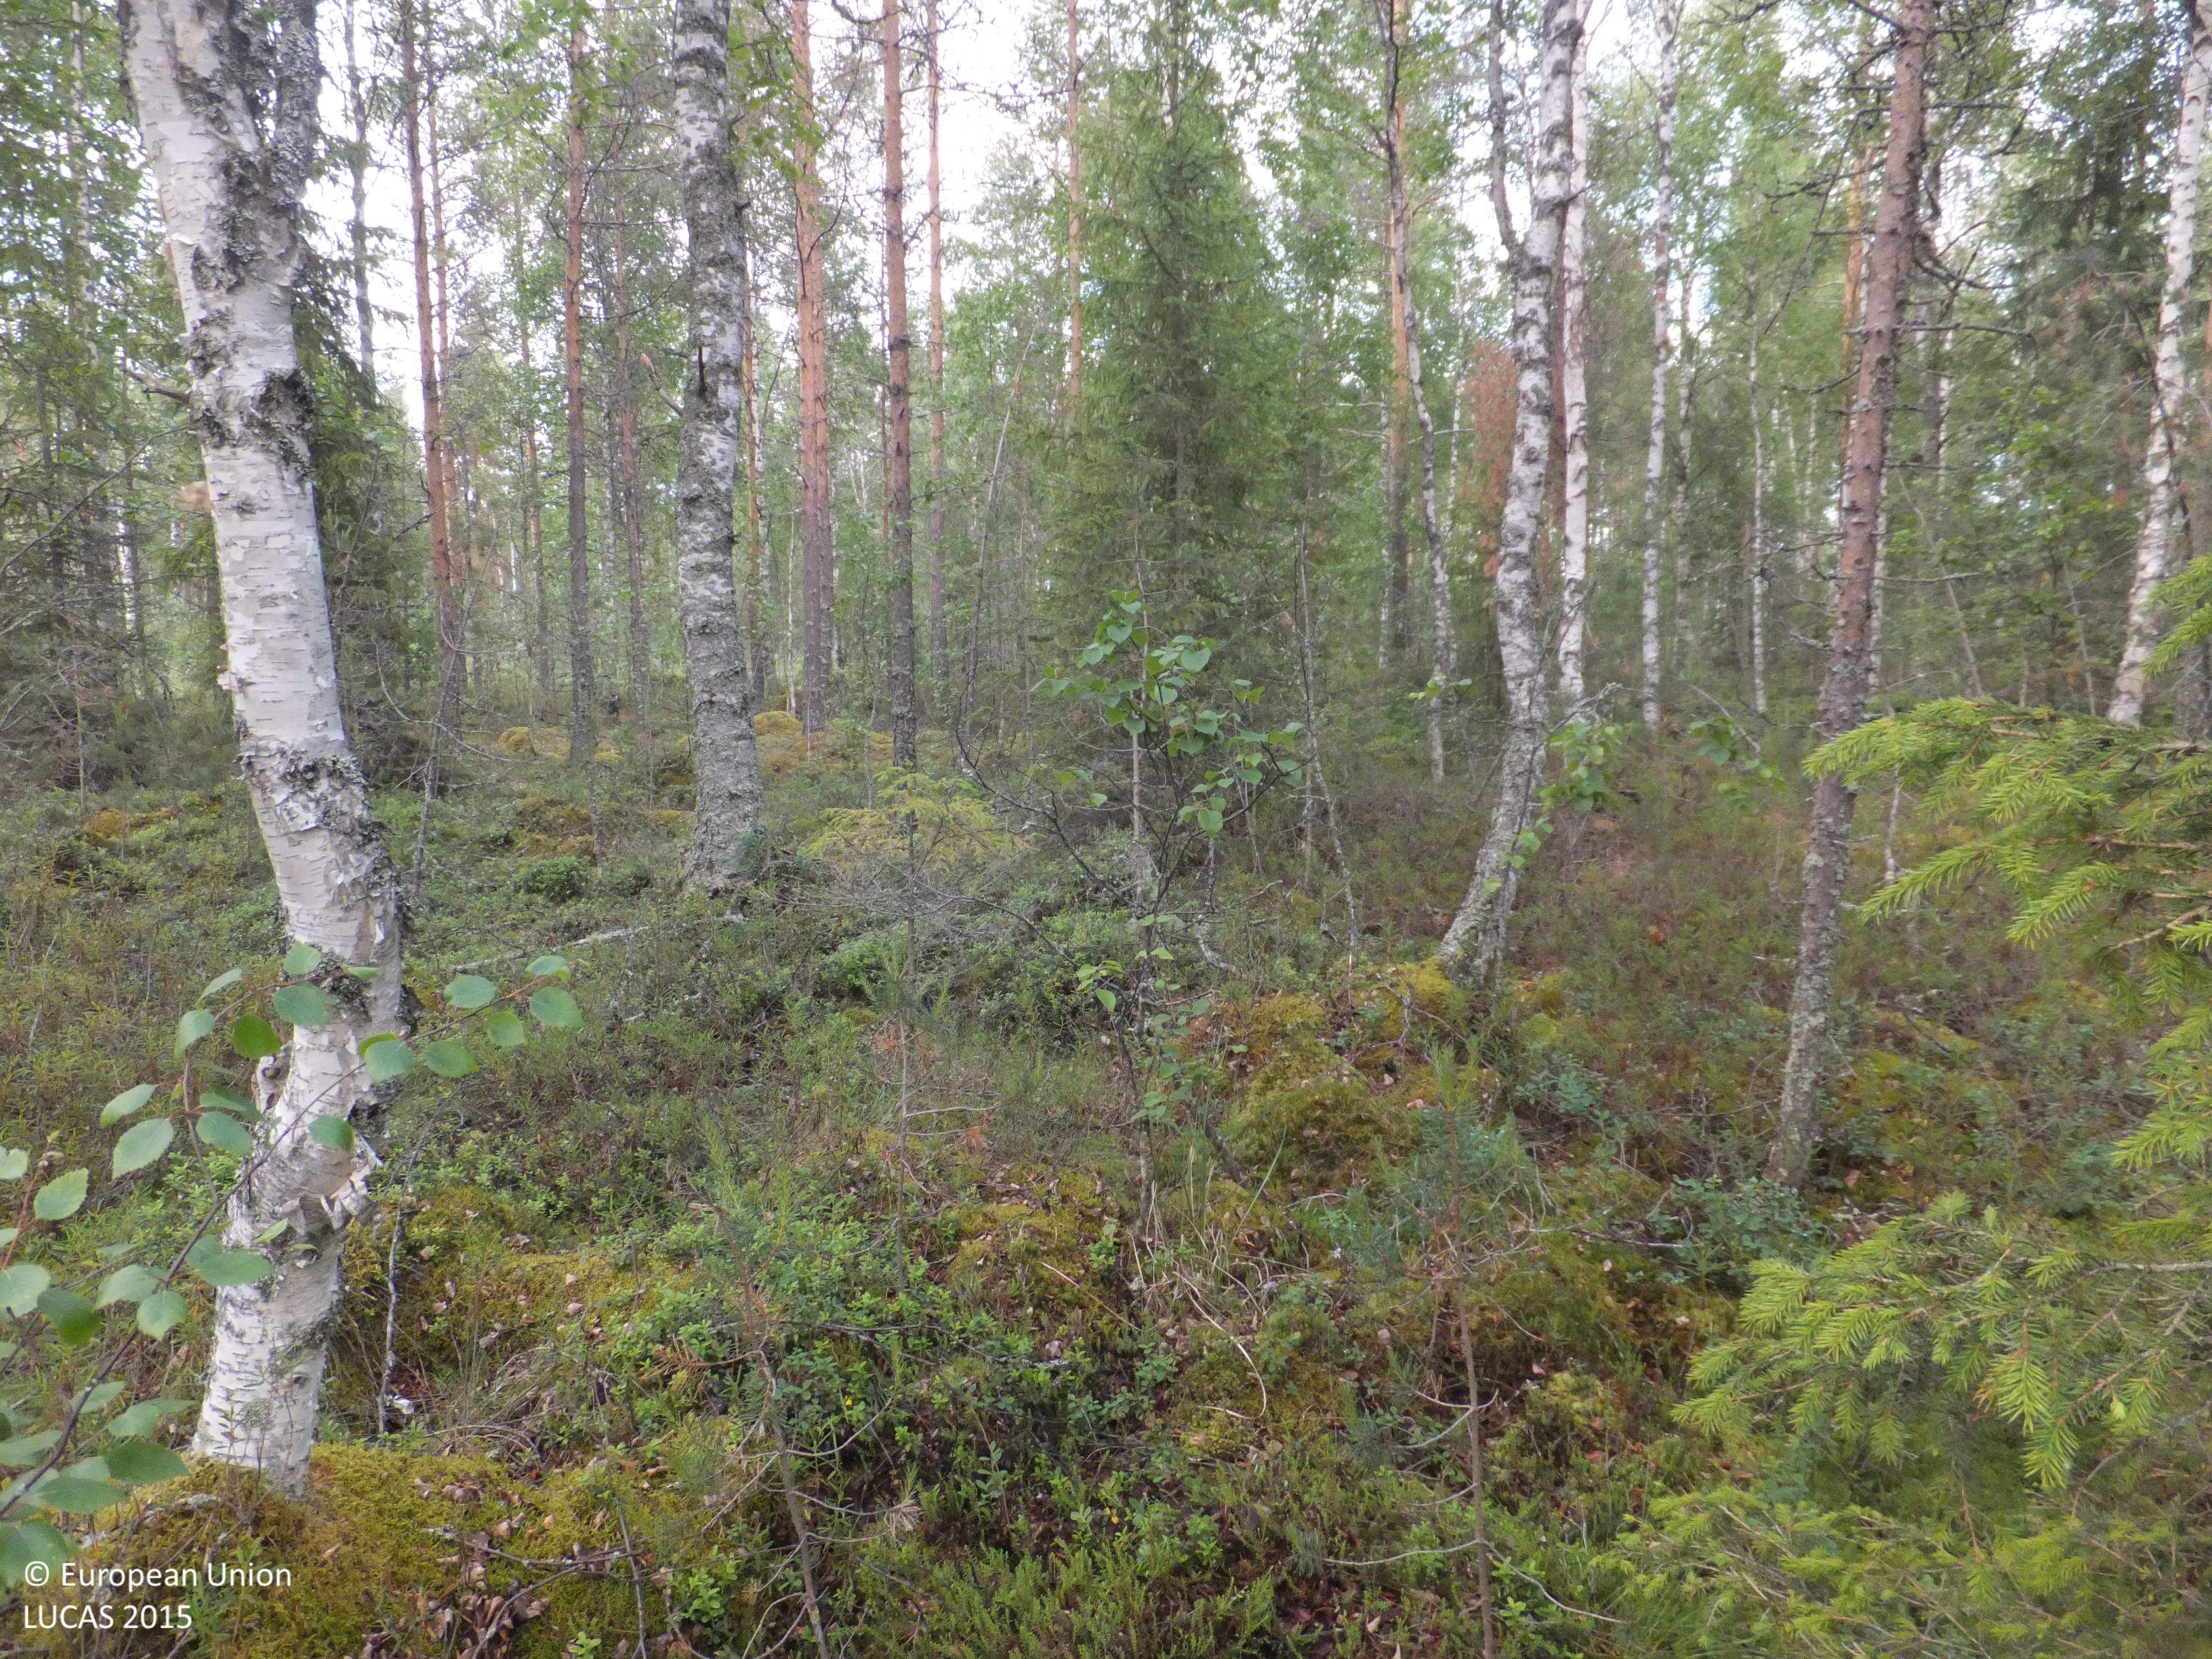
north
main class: Woodland
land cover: Pine dominated mixed woodland
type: boreal forest
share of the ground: > 75 %
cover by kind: broadleaved forest trees 60 %, coniferous forest trees 20 %, shrubs 10 %, lichens and mosses 10 %
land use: Forestry
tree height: > 5 m
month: July
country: FI
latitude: 63.0108
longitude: 24.4829
